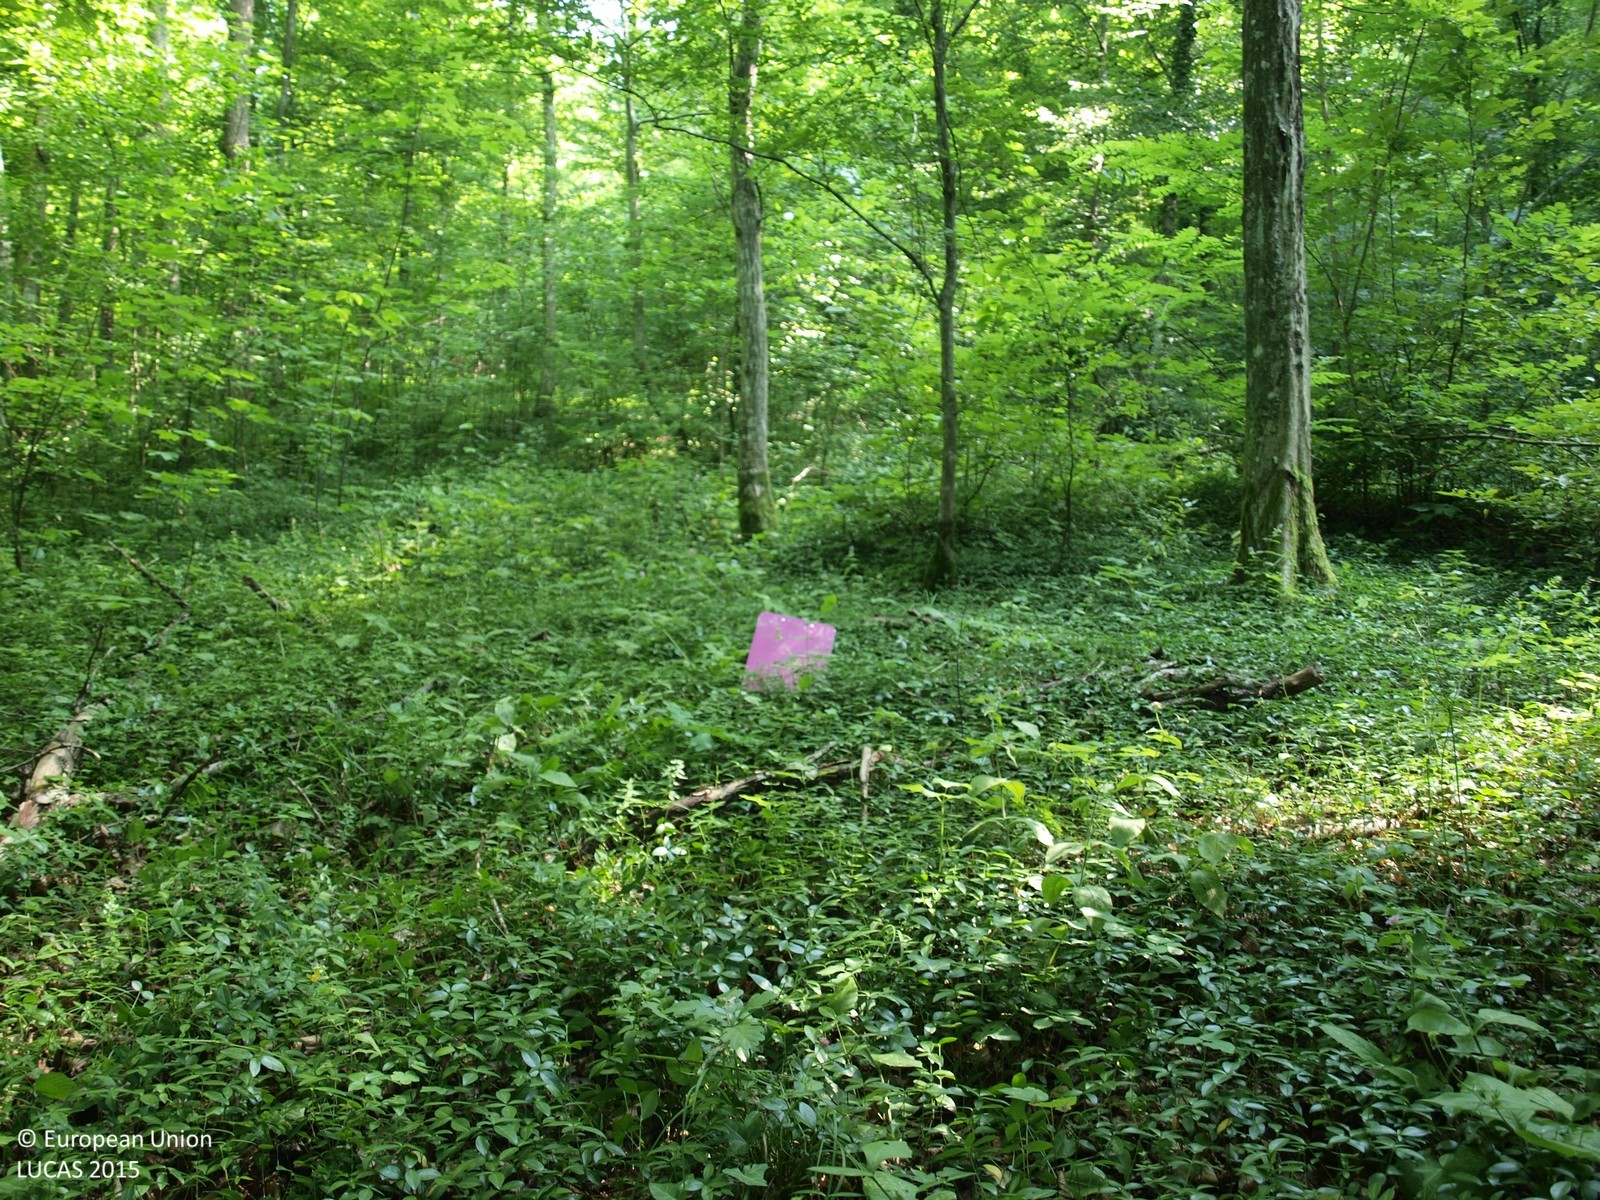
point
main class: Woodland
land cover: Broadleaved woodland
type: beech forest
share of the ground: > 75 %
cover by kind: broadleaved forest trees 100 %
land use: Forestry
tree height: > 5 m
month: July
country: HR
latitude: 46.1291
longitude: 15.9912
